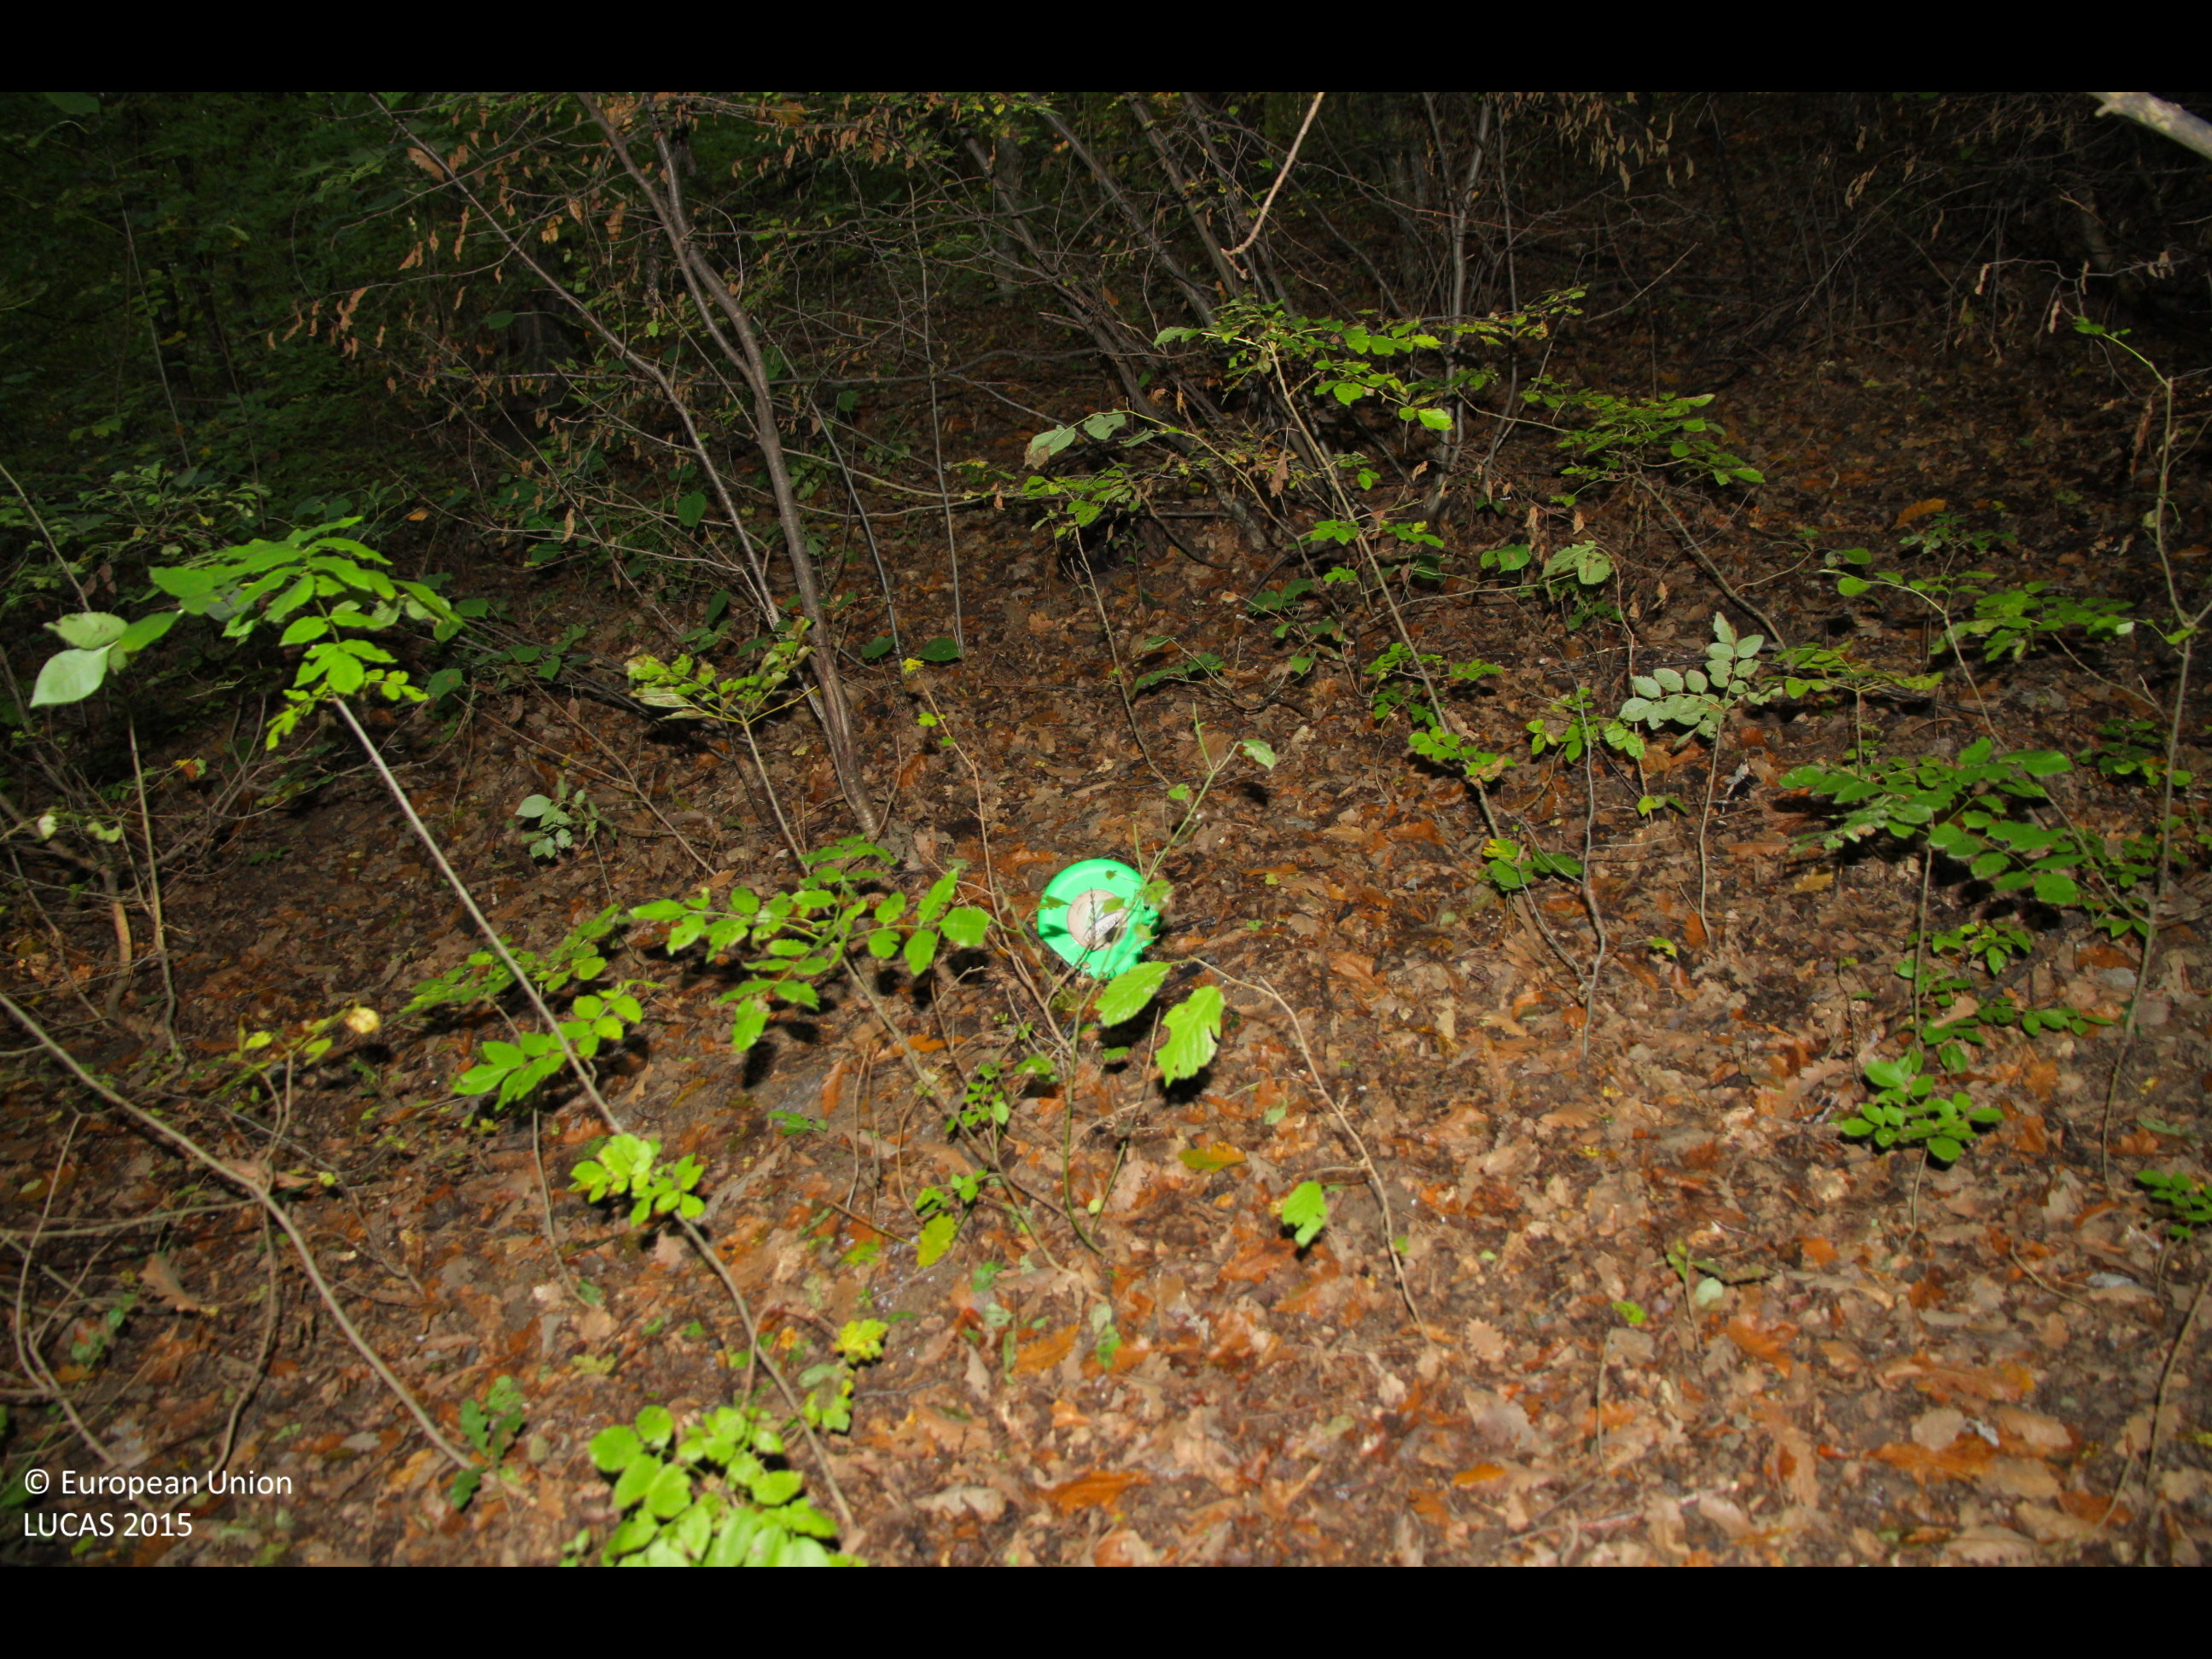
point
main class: Woodland
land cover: Broadleaved woodland
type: mesophytic deciduous forest
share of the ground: > 75 %
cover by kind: broadleaved forest trees 100 %
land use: Forestry
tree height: > 5 m
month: October
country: BG
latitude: 43.0337
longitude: 26.9620
